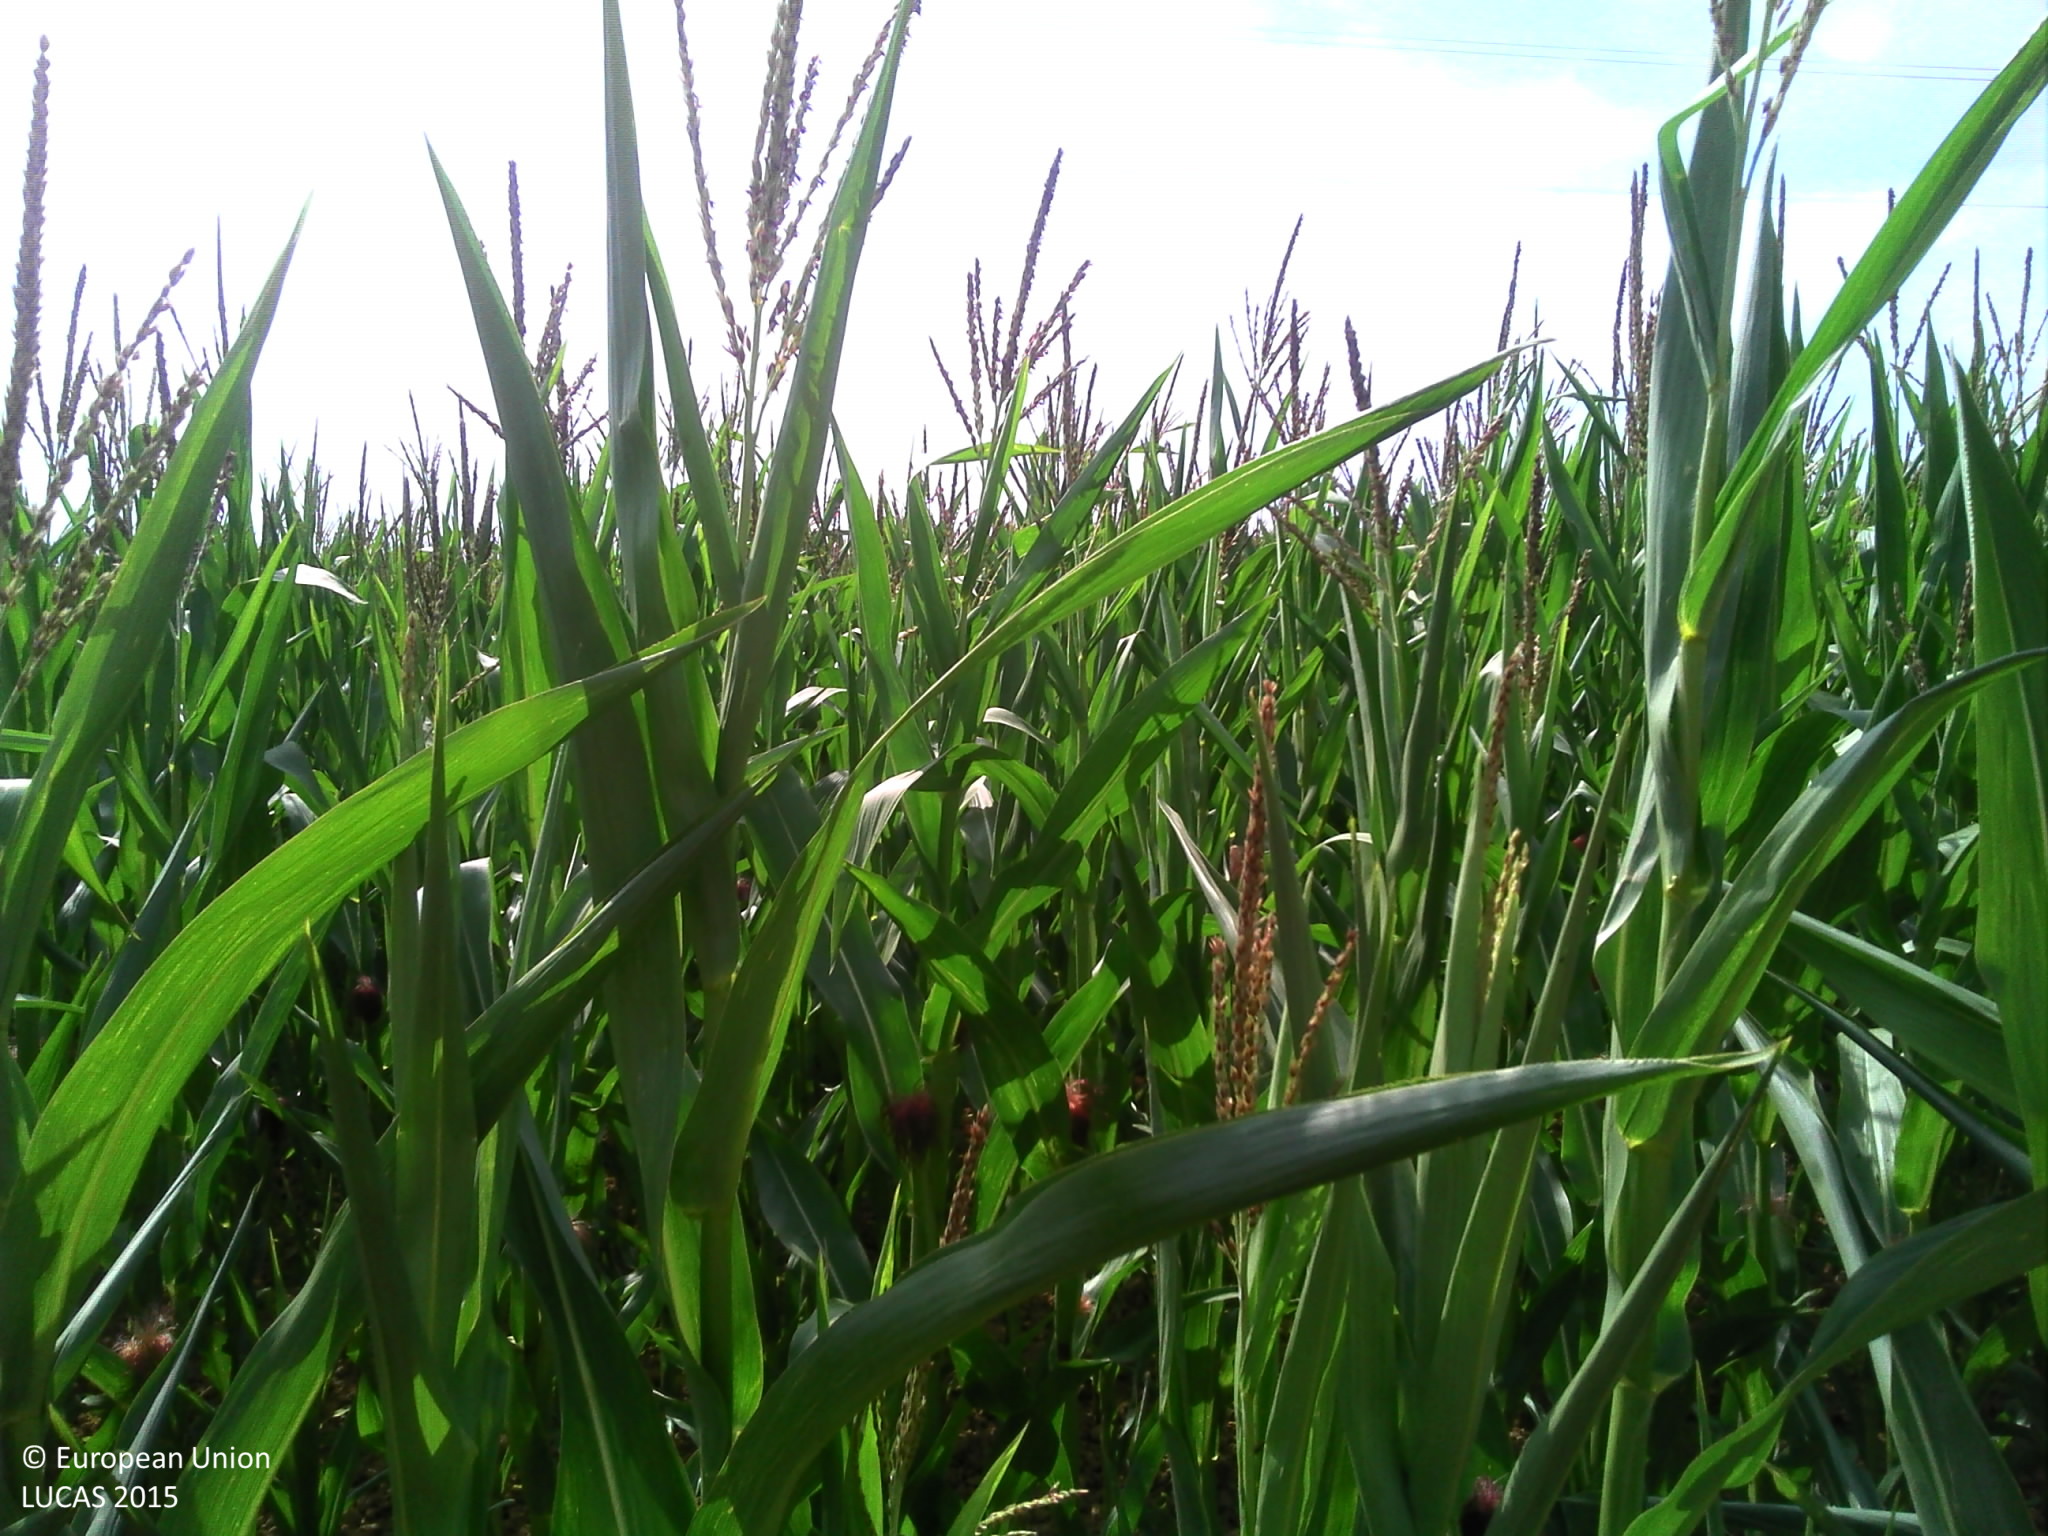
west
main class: Cropland
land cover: Maize
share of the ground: > 75 %
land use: Agriculture (excluding fallow land and kitchen gardens)
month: August
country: FR
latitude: 48.6532
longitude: 3.3279
